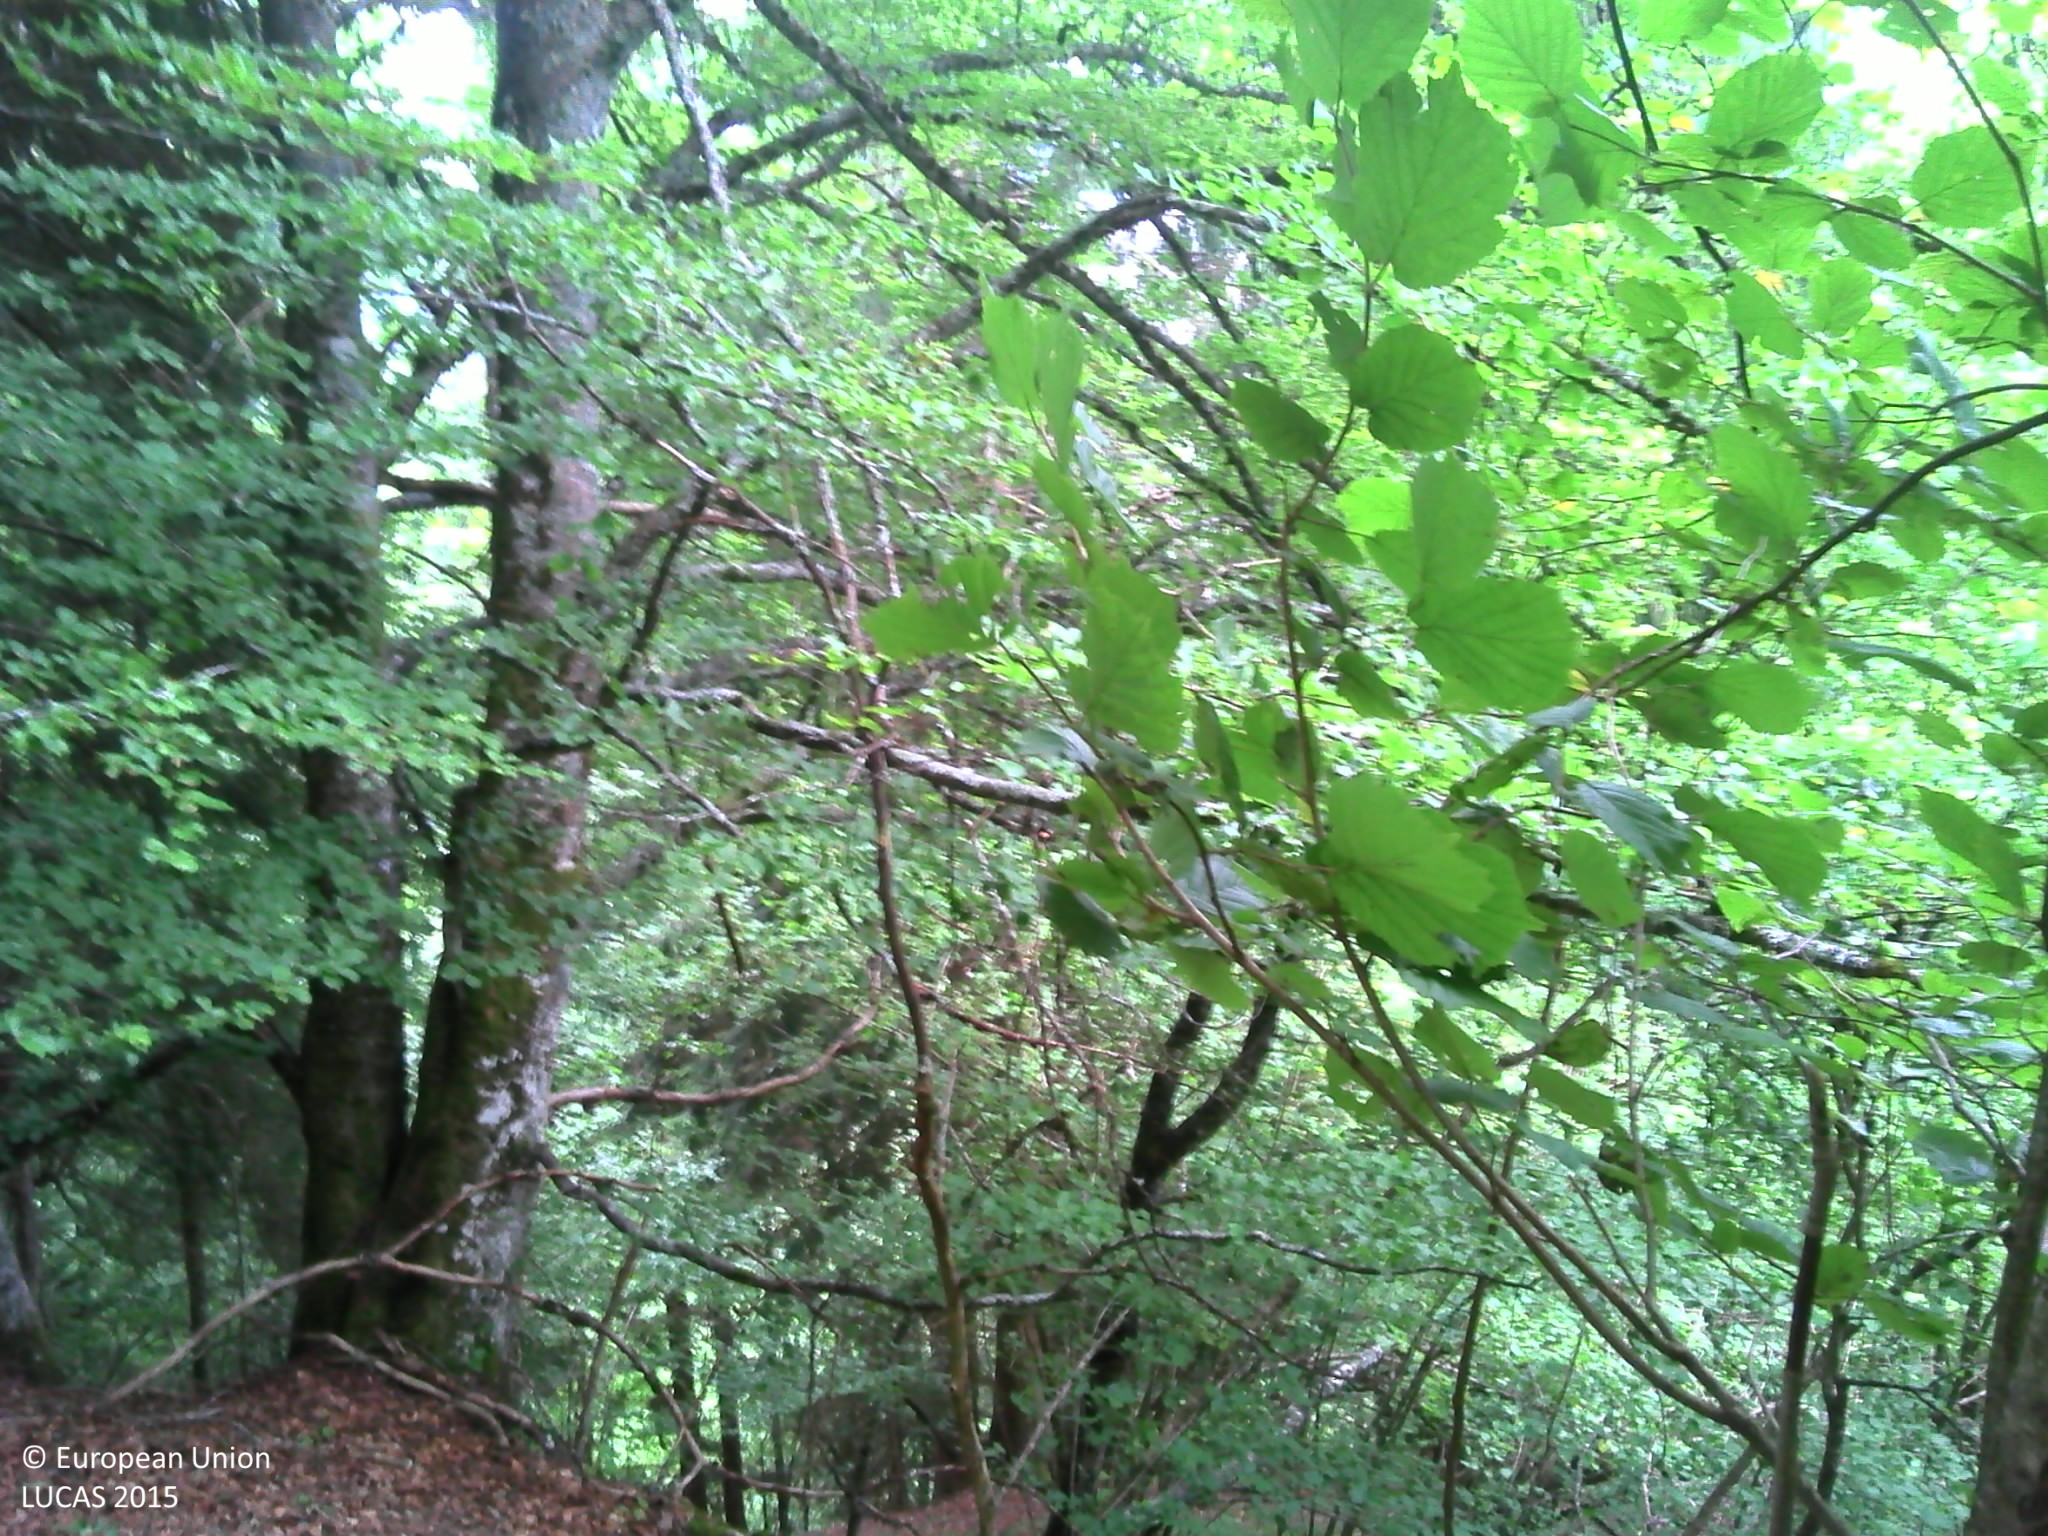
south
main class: Woodland
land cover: Spruce dominated mixed woodland
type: mountainous beech forest
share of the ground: > 75 %
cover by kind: broadleaved forest trees 40 %, coniferous forest trees 35 %, herbaceous plants 20 %, lichens and mosses 5 %
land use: Forestry
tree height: > 5 m
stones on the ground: < 10 %
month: July
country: FR
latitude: 45.9482
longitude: 6.4047
